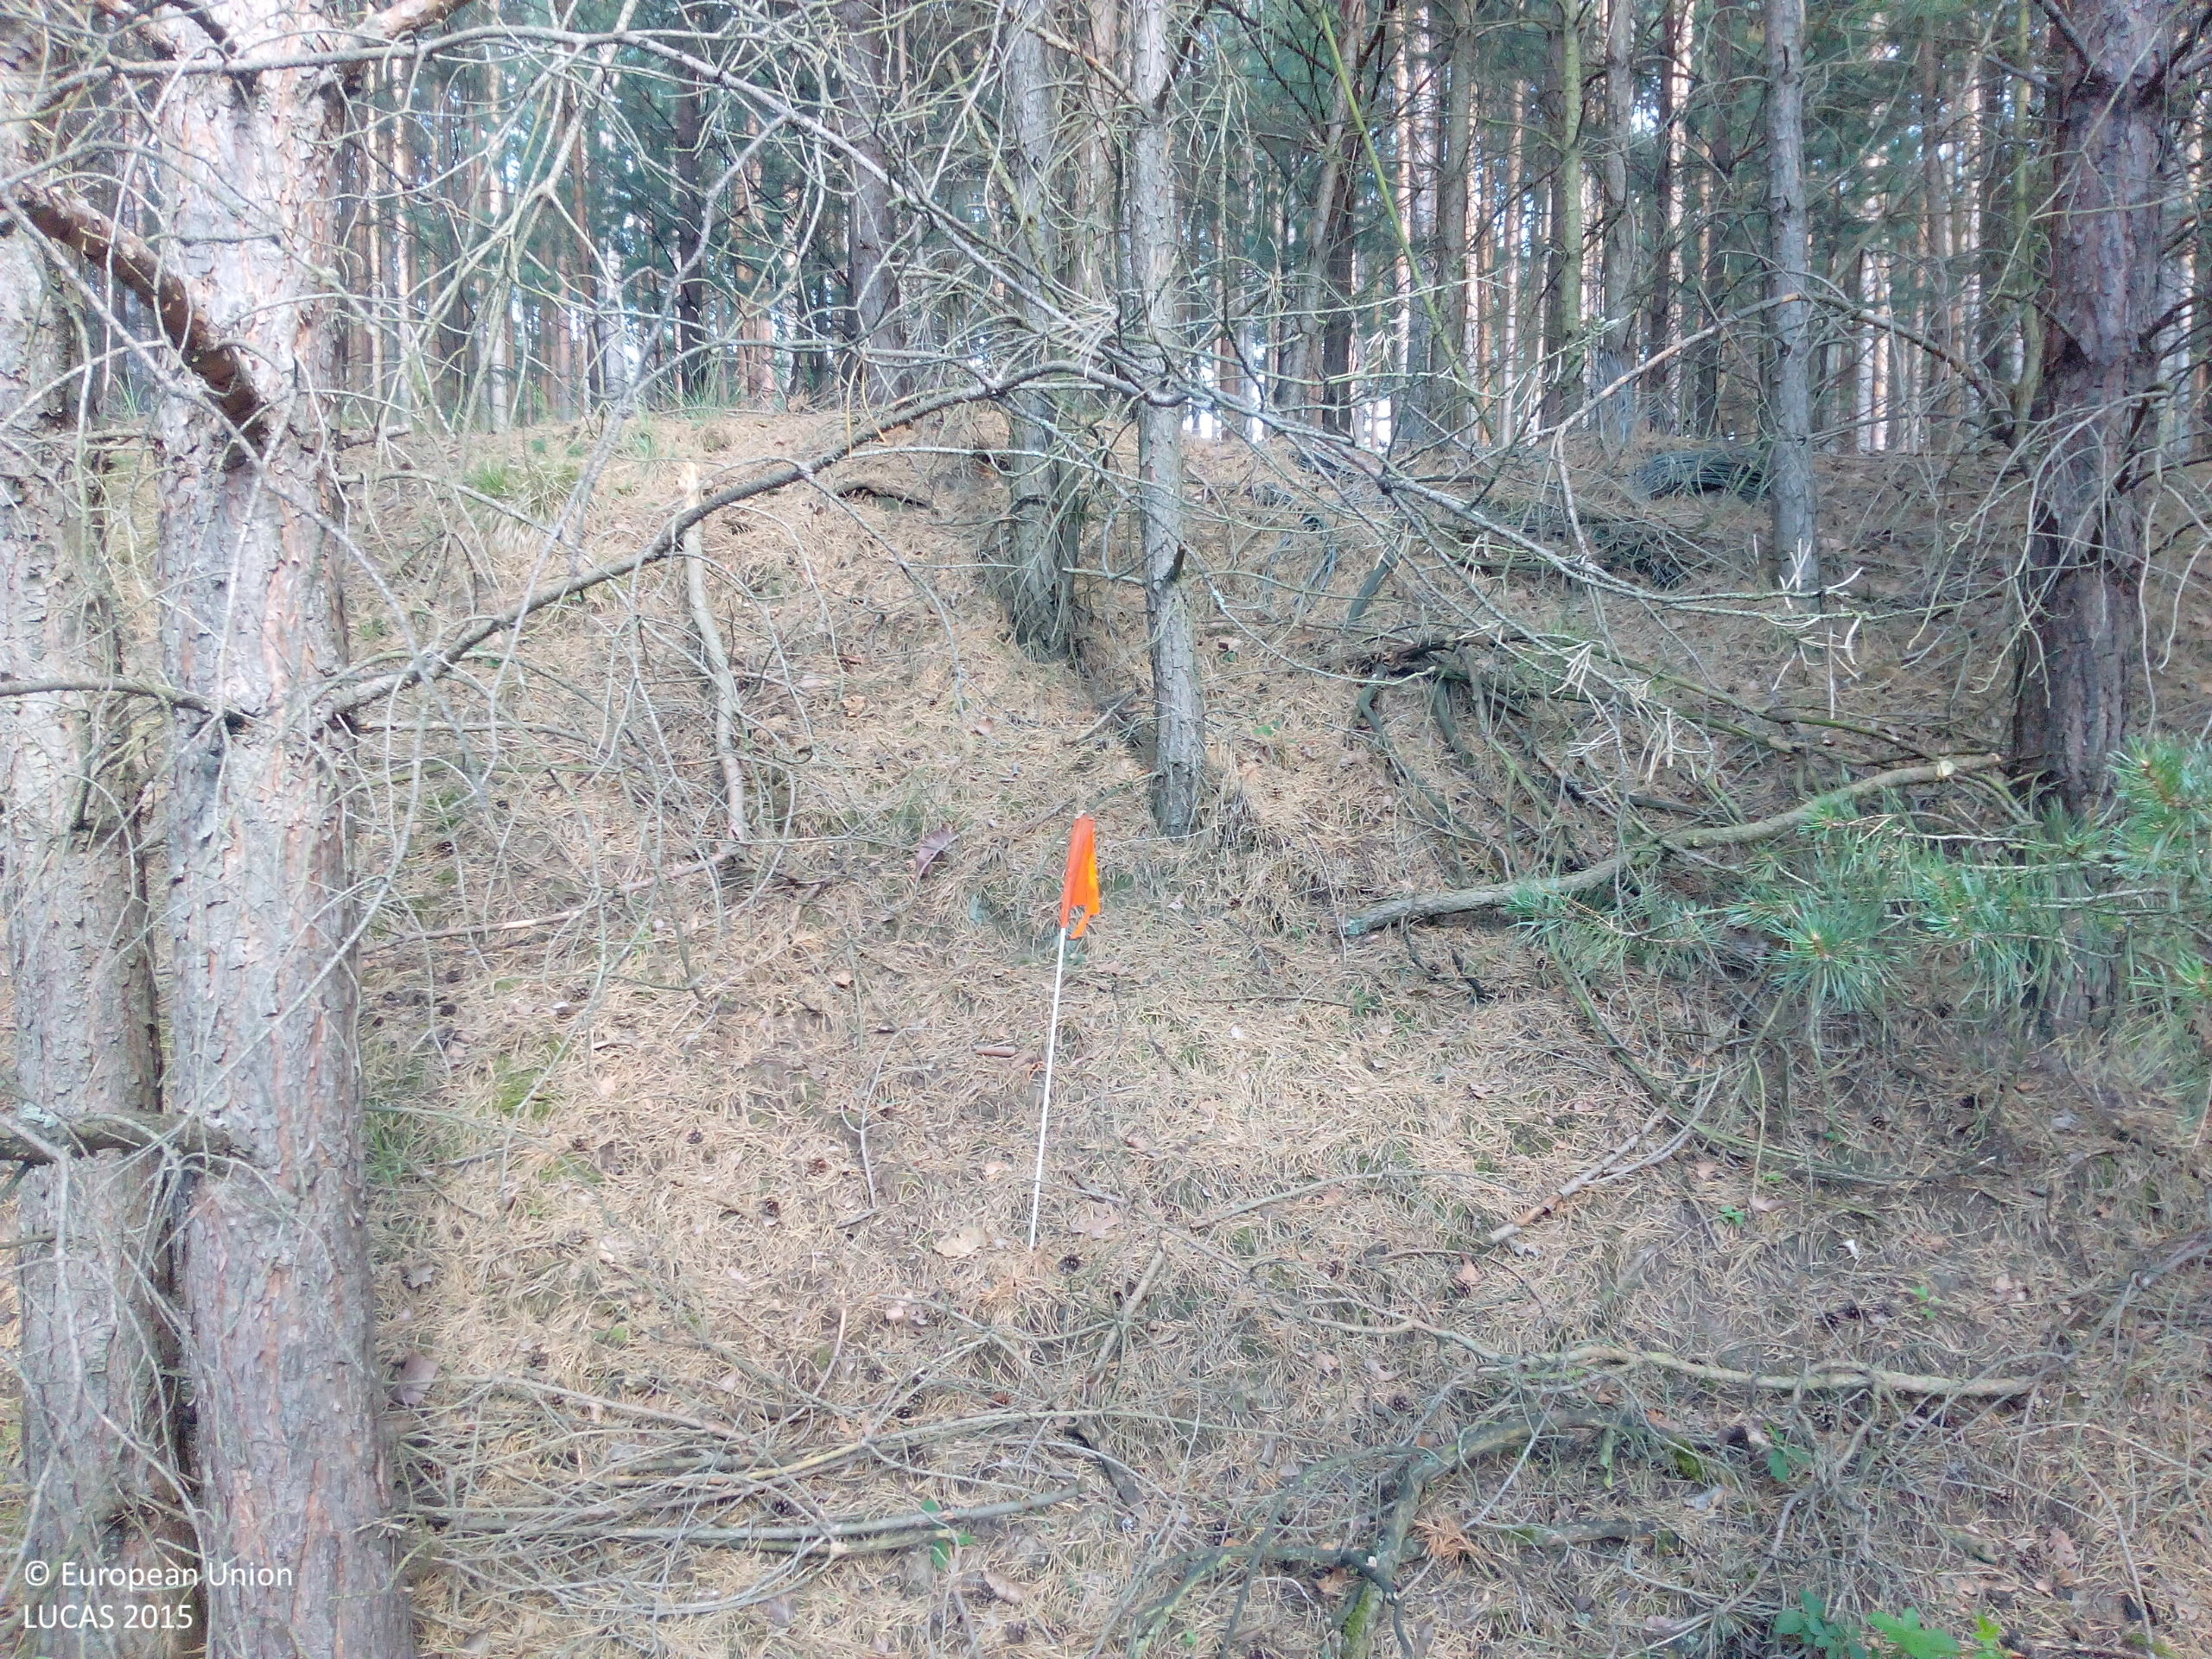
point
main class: Woodland
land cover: Pine dominated coniferous woodland
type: hemiboreal forest and nemoral coniferous forest and mixed broadleaved-coniferous forest
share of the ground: > 75 %
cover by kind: coniferous forest trees 100 %
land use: Forestry
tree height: > 5 m
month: July
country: DE
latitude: 51.6072
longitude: 14.0297
